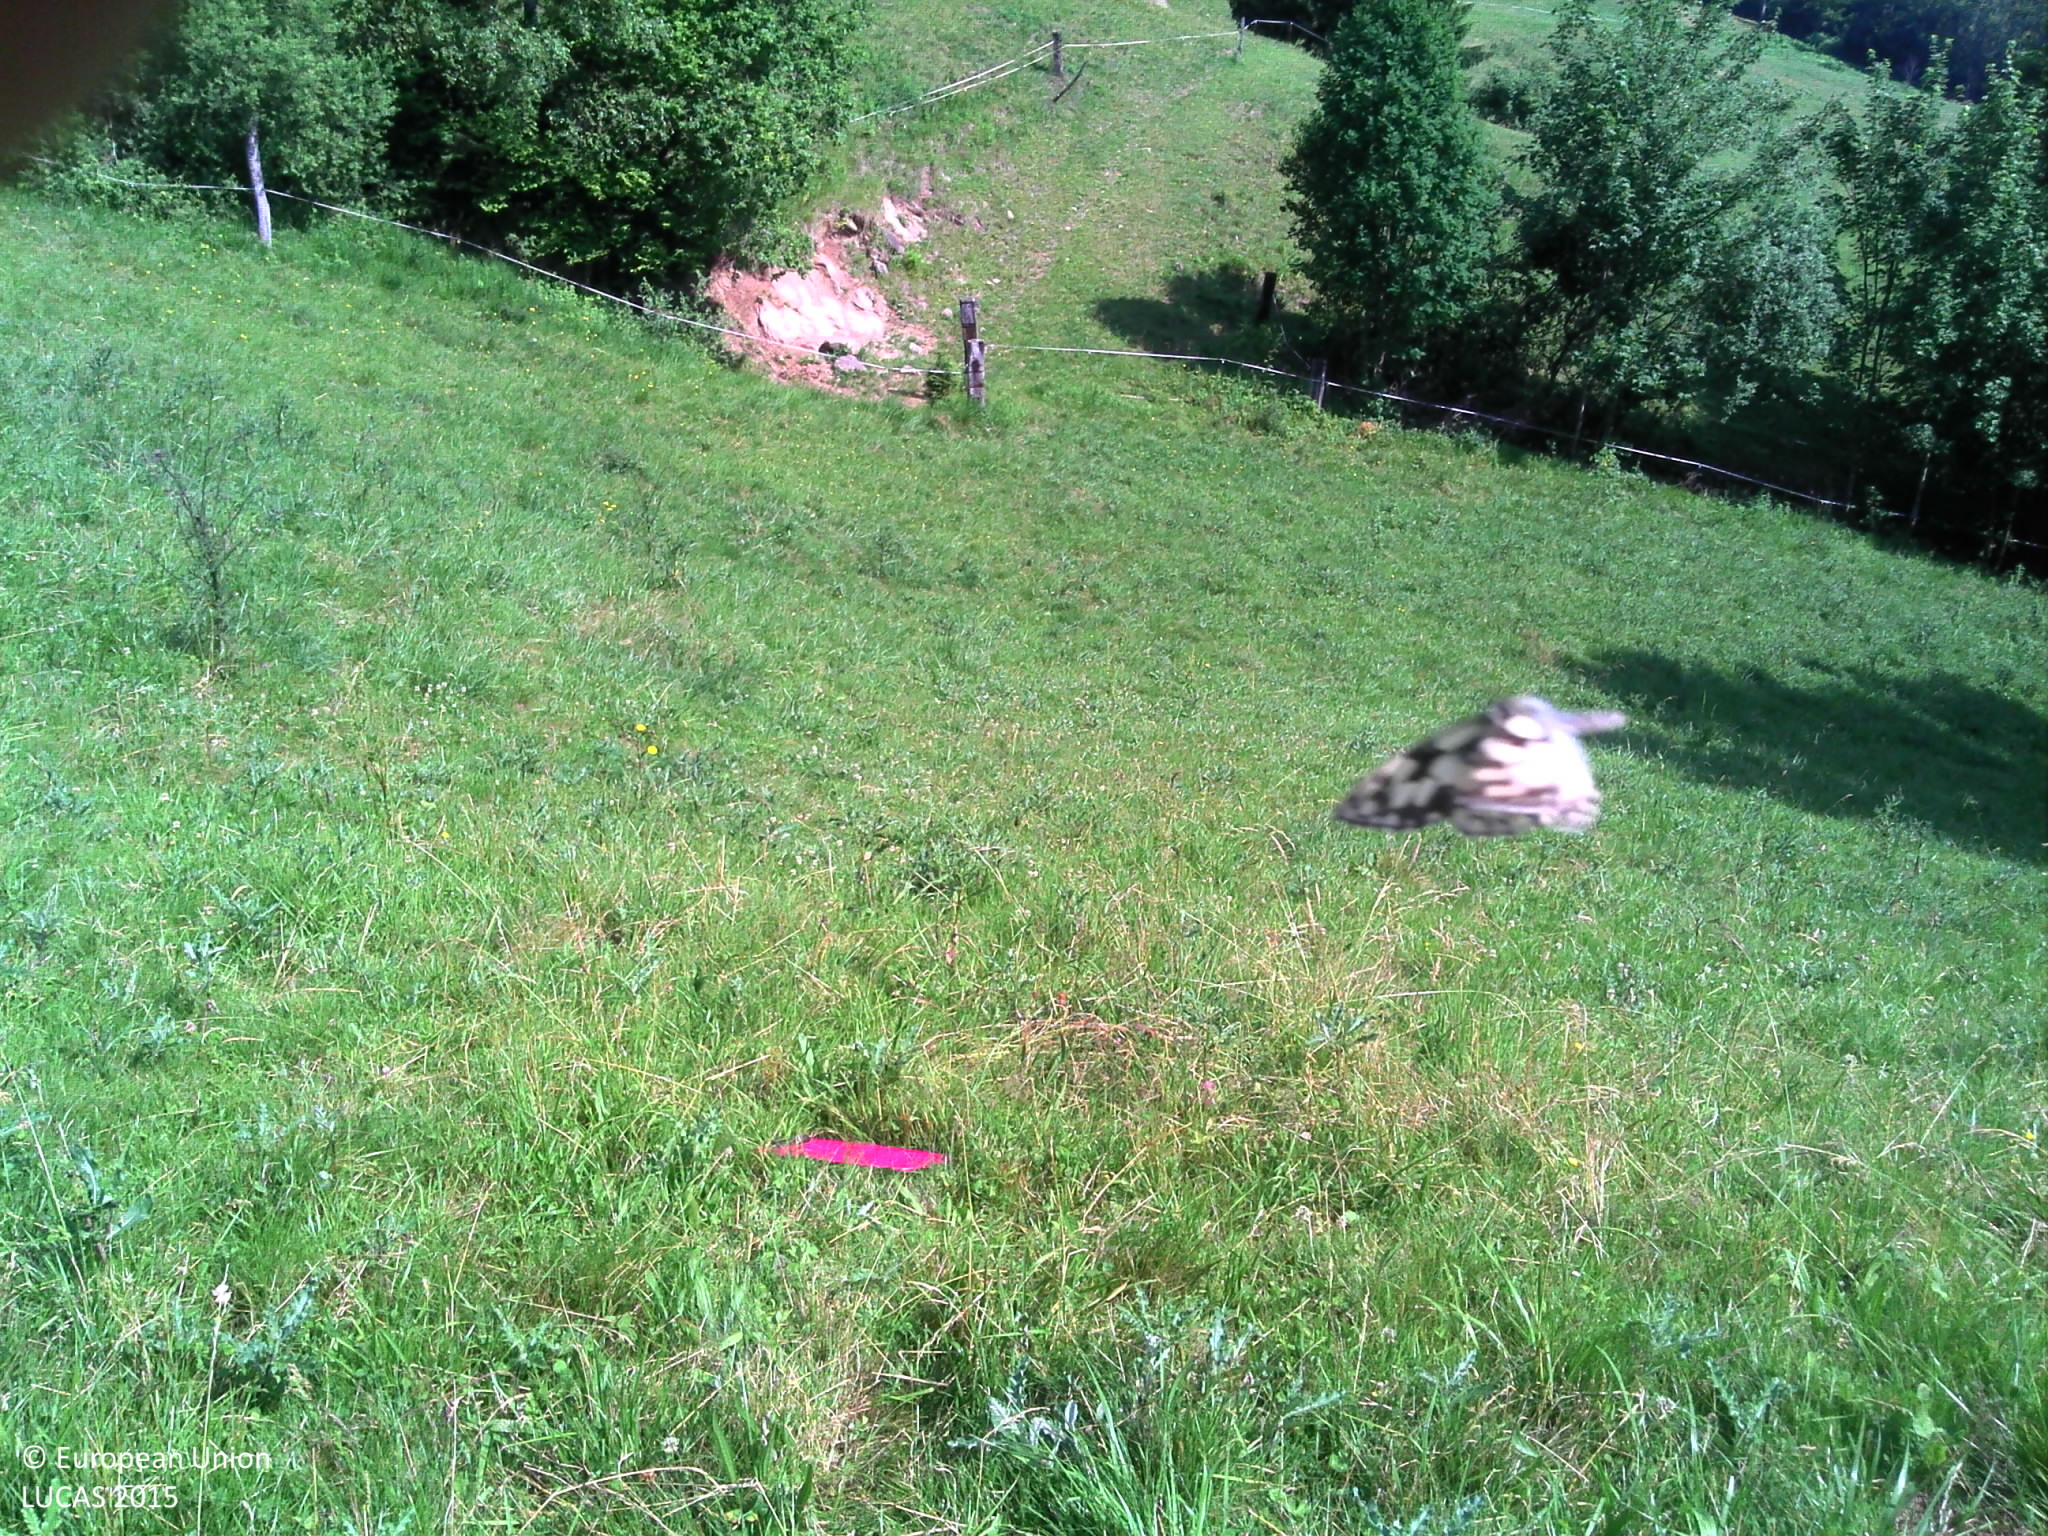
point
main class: Grassland
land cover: Grassland without tree/shrub cover
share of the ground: > 75 %
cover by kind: herbaceous plants 100 %
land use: Agriculture (excluding fallow land and kitchen gardens)
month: July
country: FR
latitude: 45.7944
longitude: 6.1318
